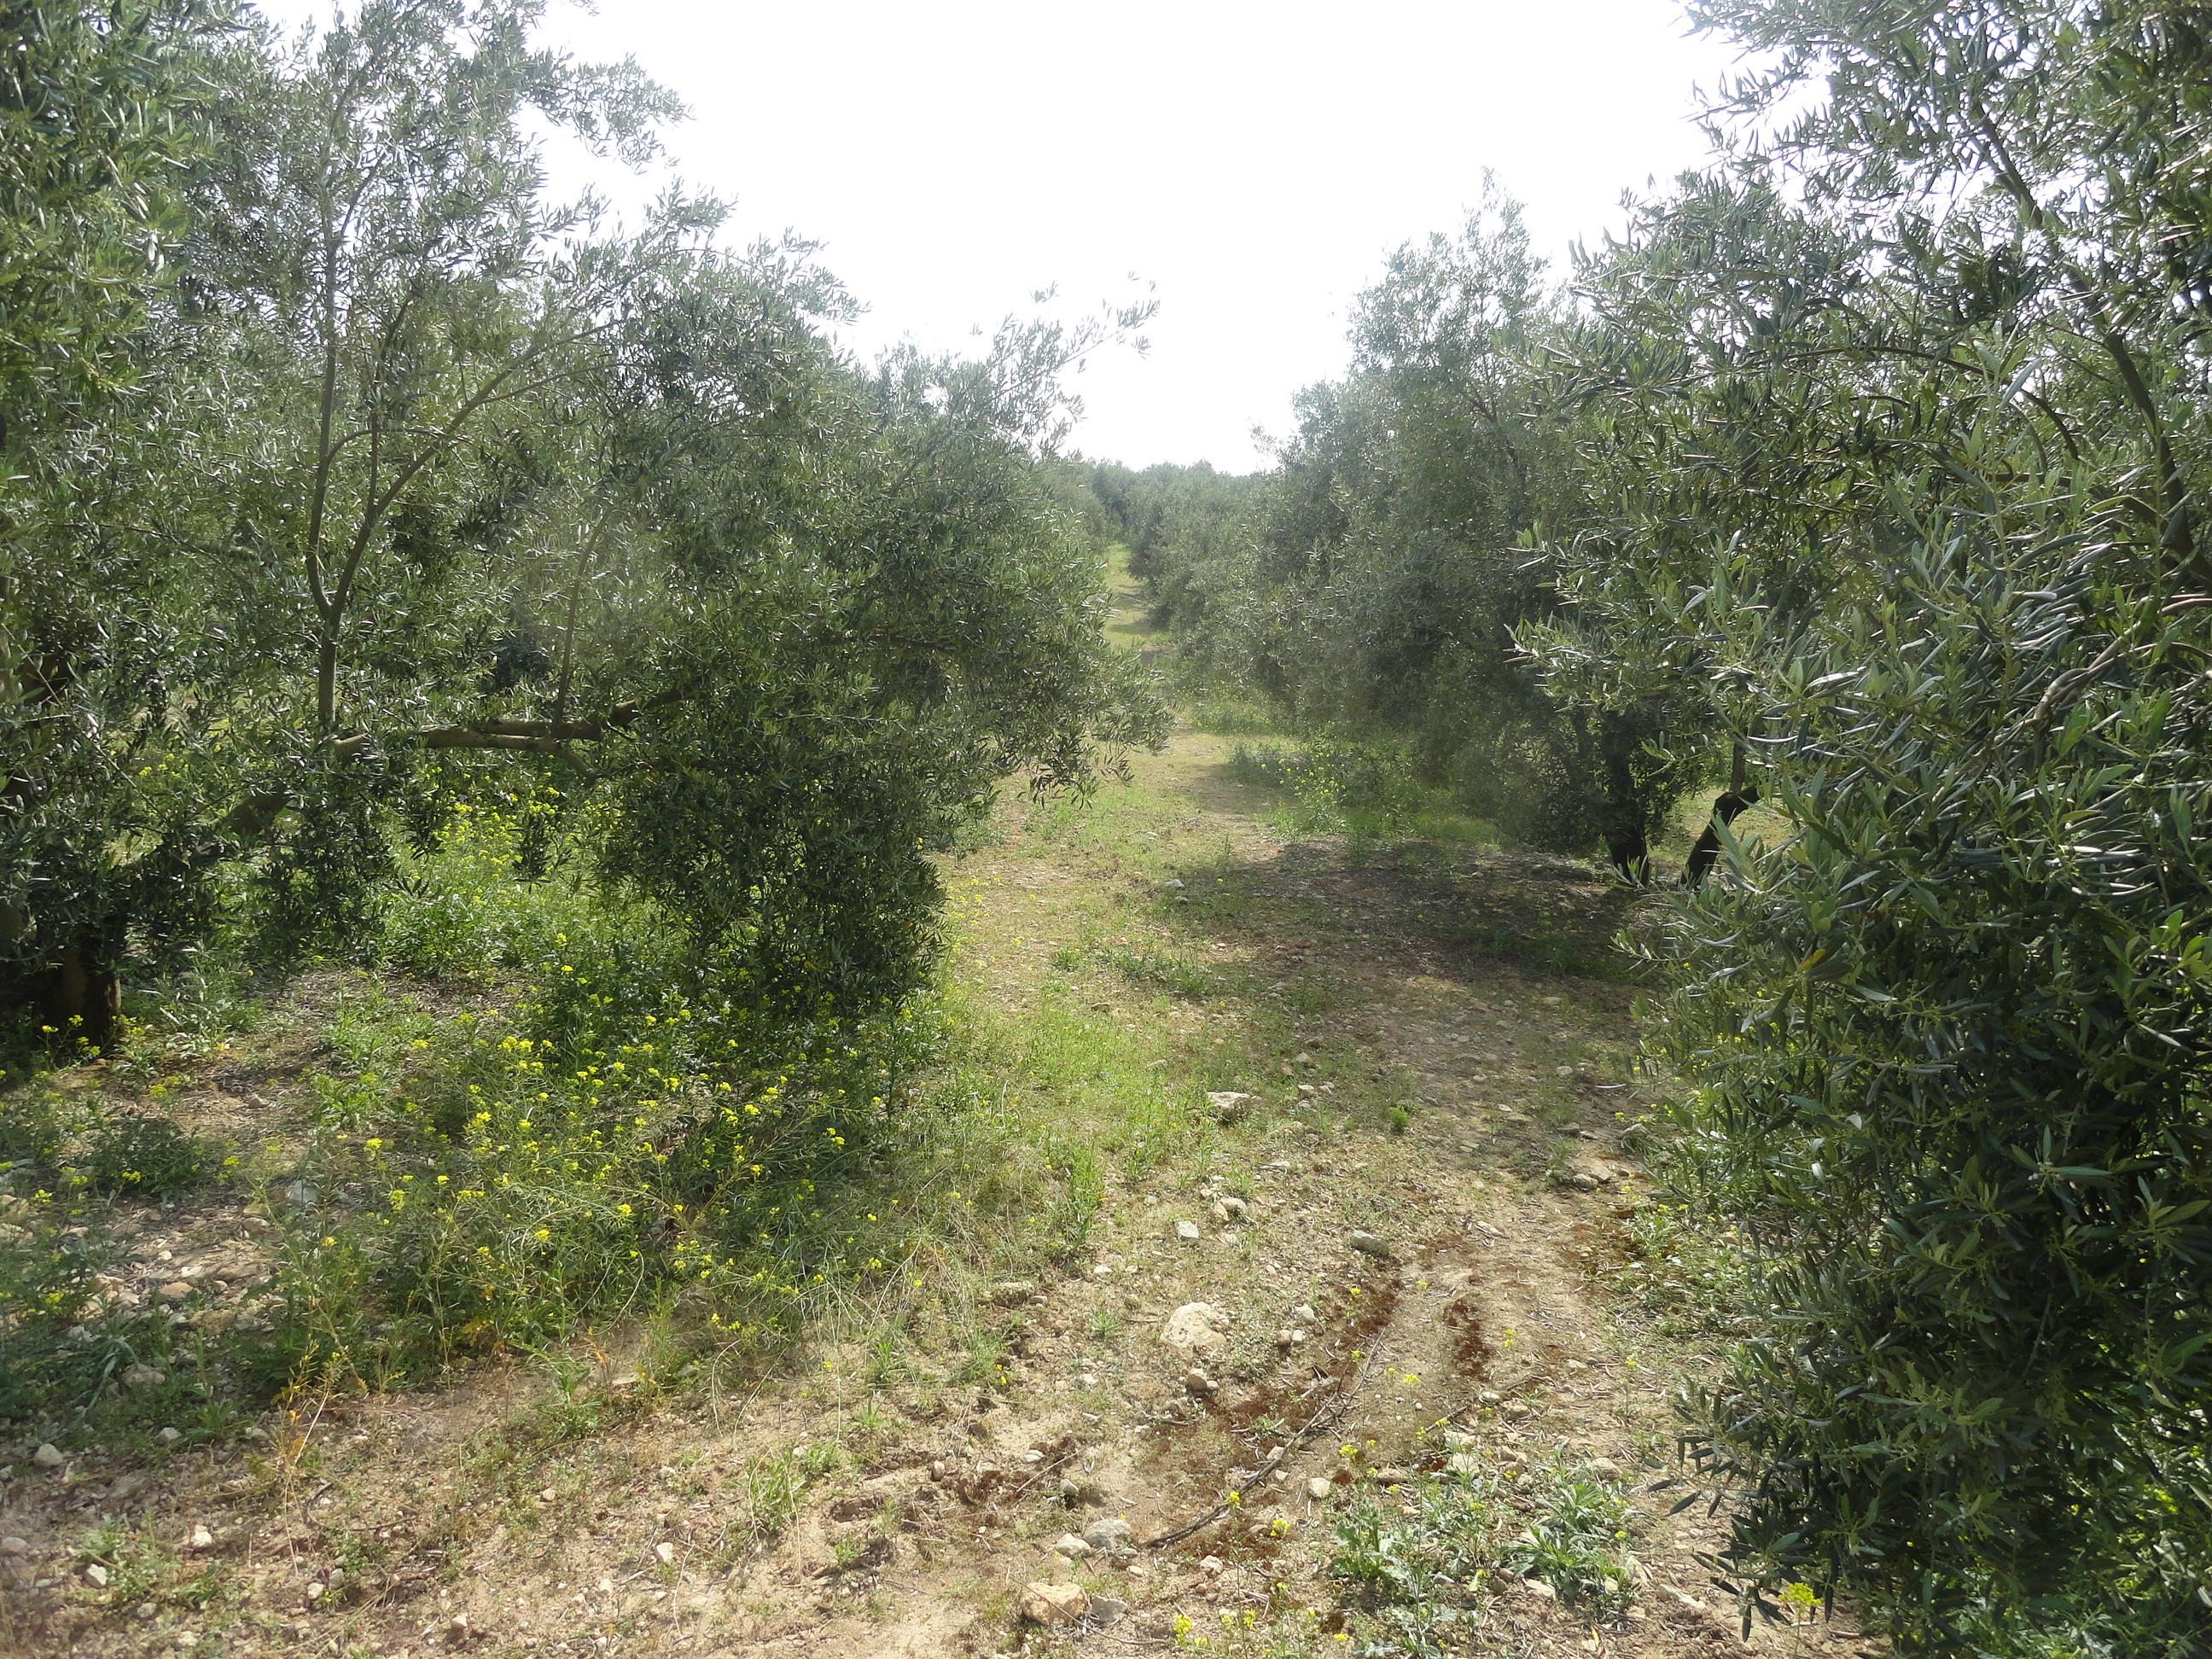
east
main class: Cropland
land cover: Olive groves
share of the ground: 50 - 75 %
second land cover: Spontaneously vegetated surfaces
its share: 25 - 50 %
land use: Agriculture (excluding fallow land and kitchen gardens)
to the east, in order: Olive groves; Spontaneously vegetated surfaces; Tracks; Rock outcrops; Olive groves
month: April
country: ES
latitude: 37.4991
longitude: -4.5857
